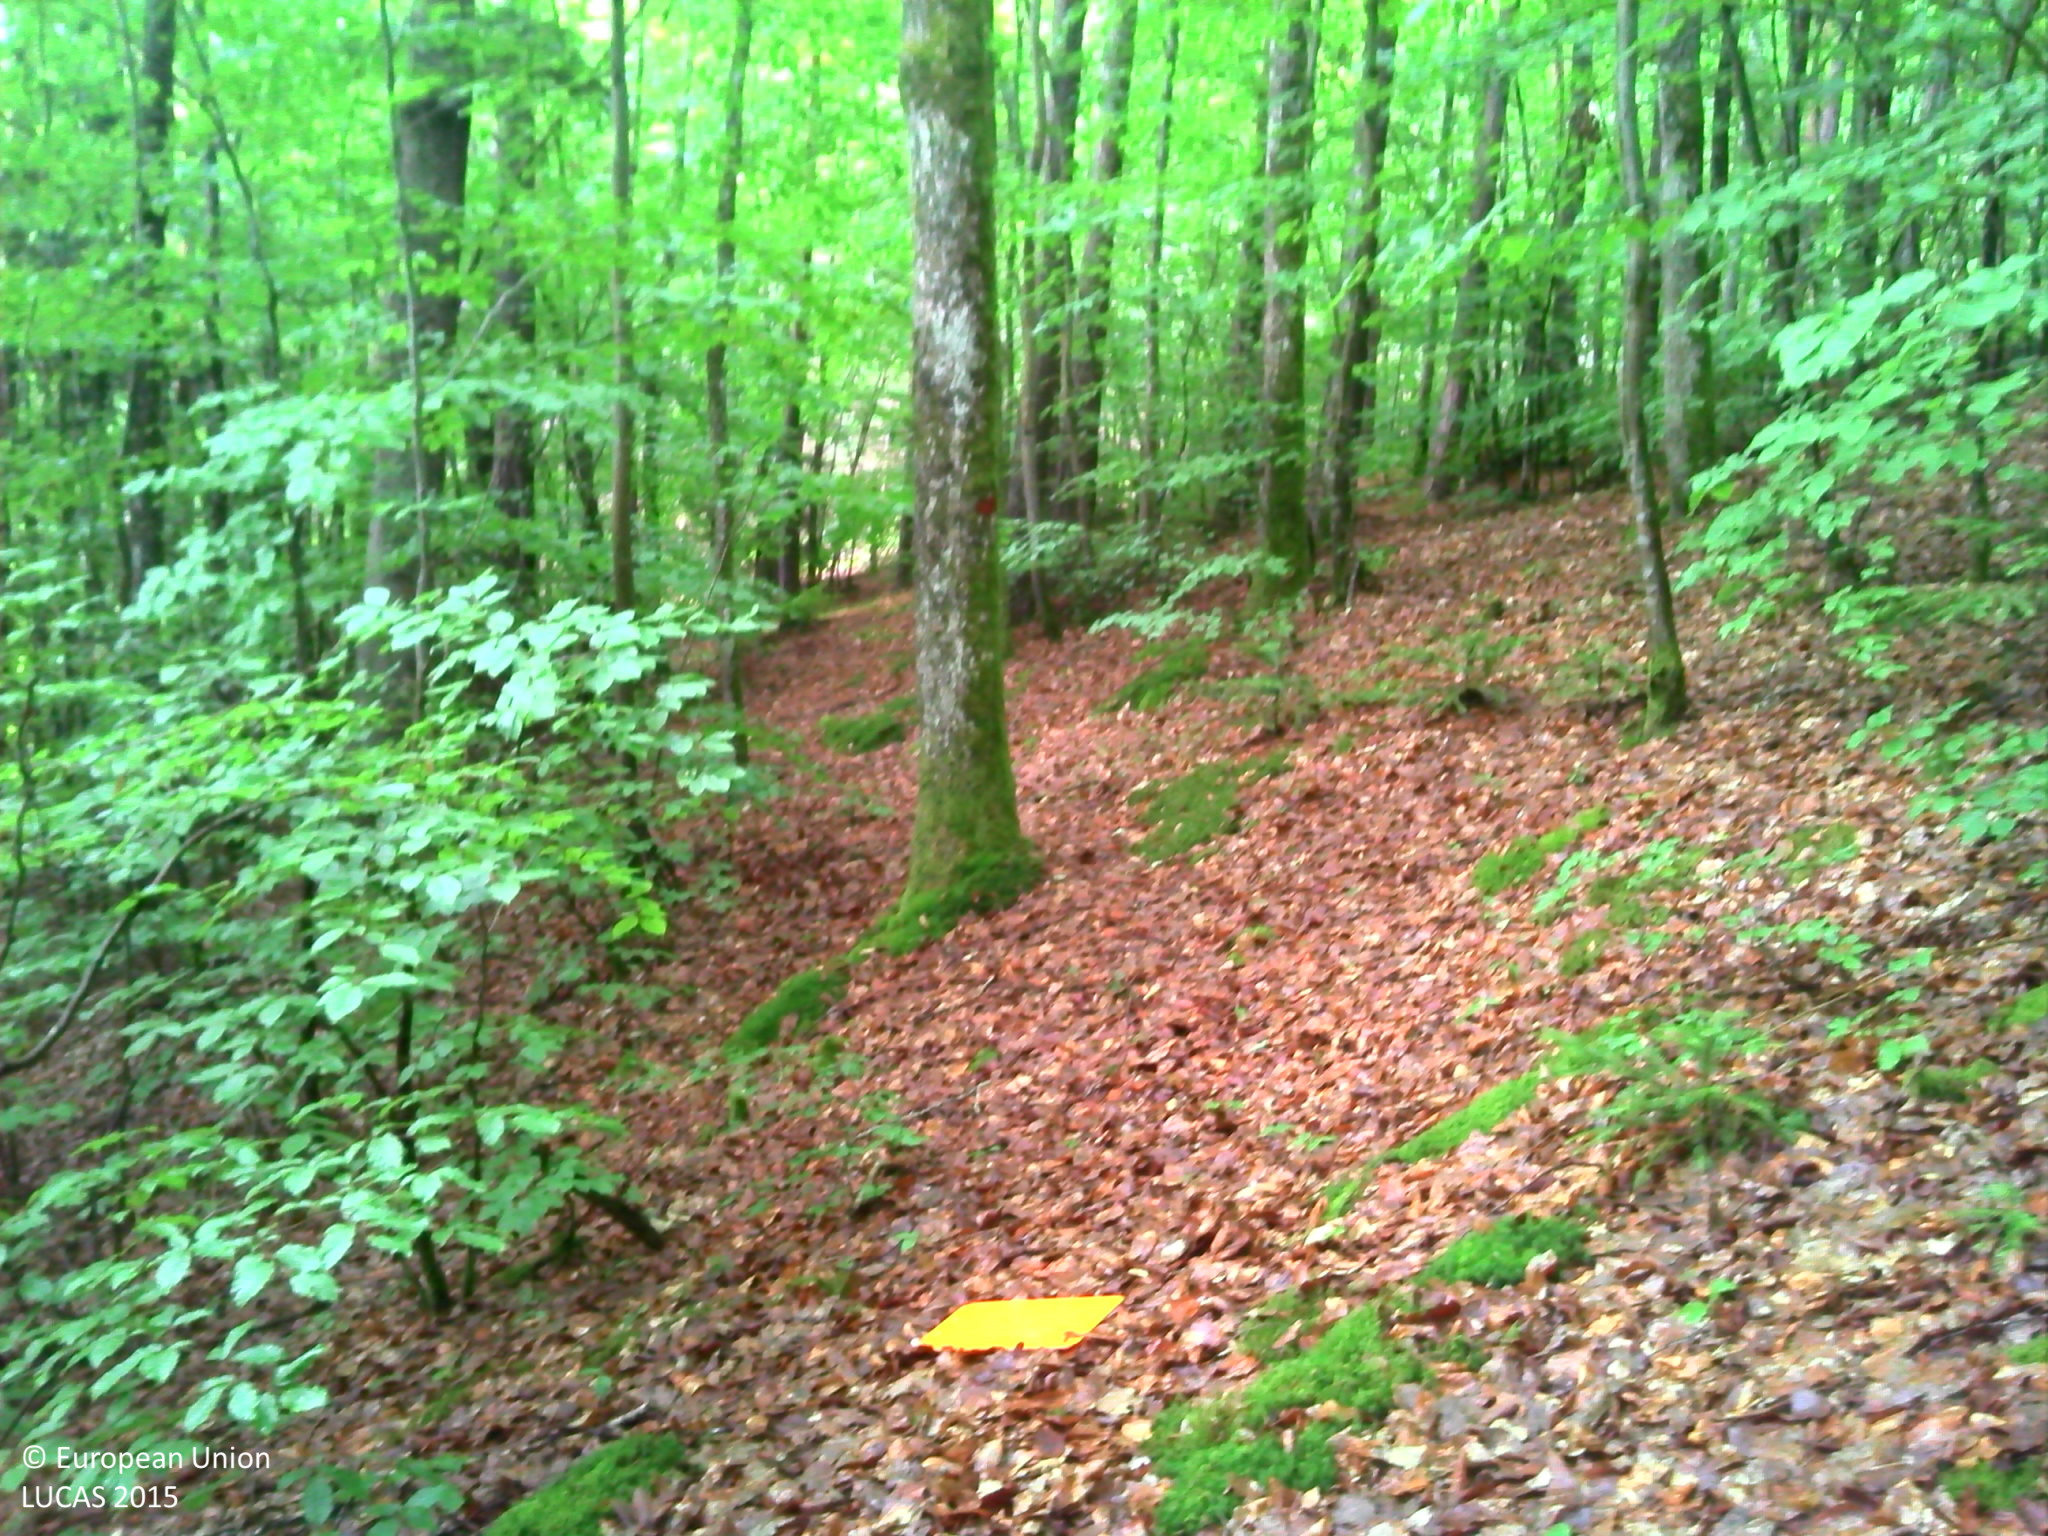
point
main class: Woodland
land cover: Spruce dominated mixed woodland
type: mountainous beech forest
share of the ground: > 75 %
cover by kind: broadleaved forest trees 60 %, coniferous forest trees 20 %, shrubs 10 %, herbaceous plants 5 %, lichens and mosses 5 %
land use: Forestry
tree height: > 5 m
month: July
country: FR
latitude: 45.1983
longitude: 4.1611
